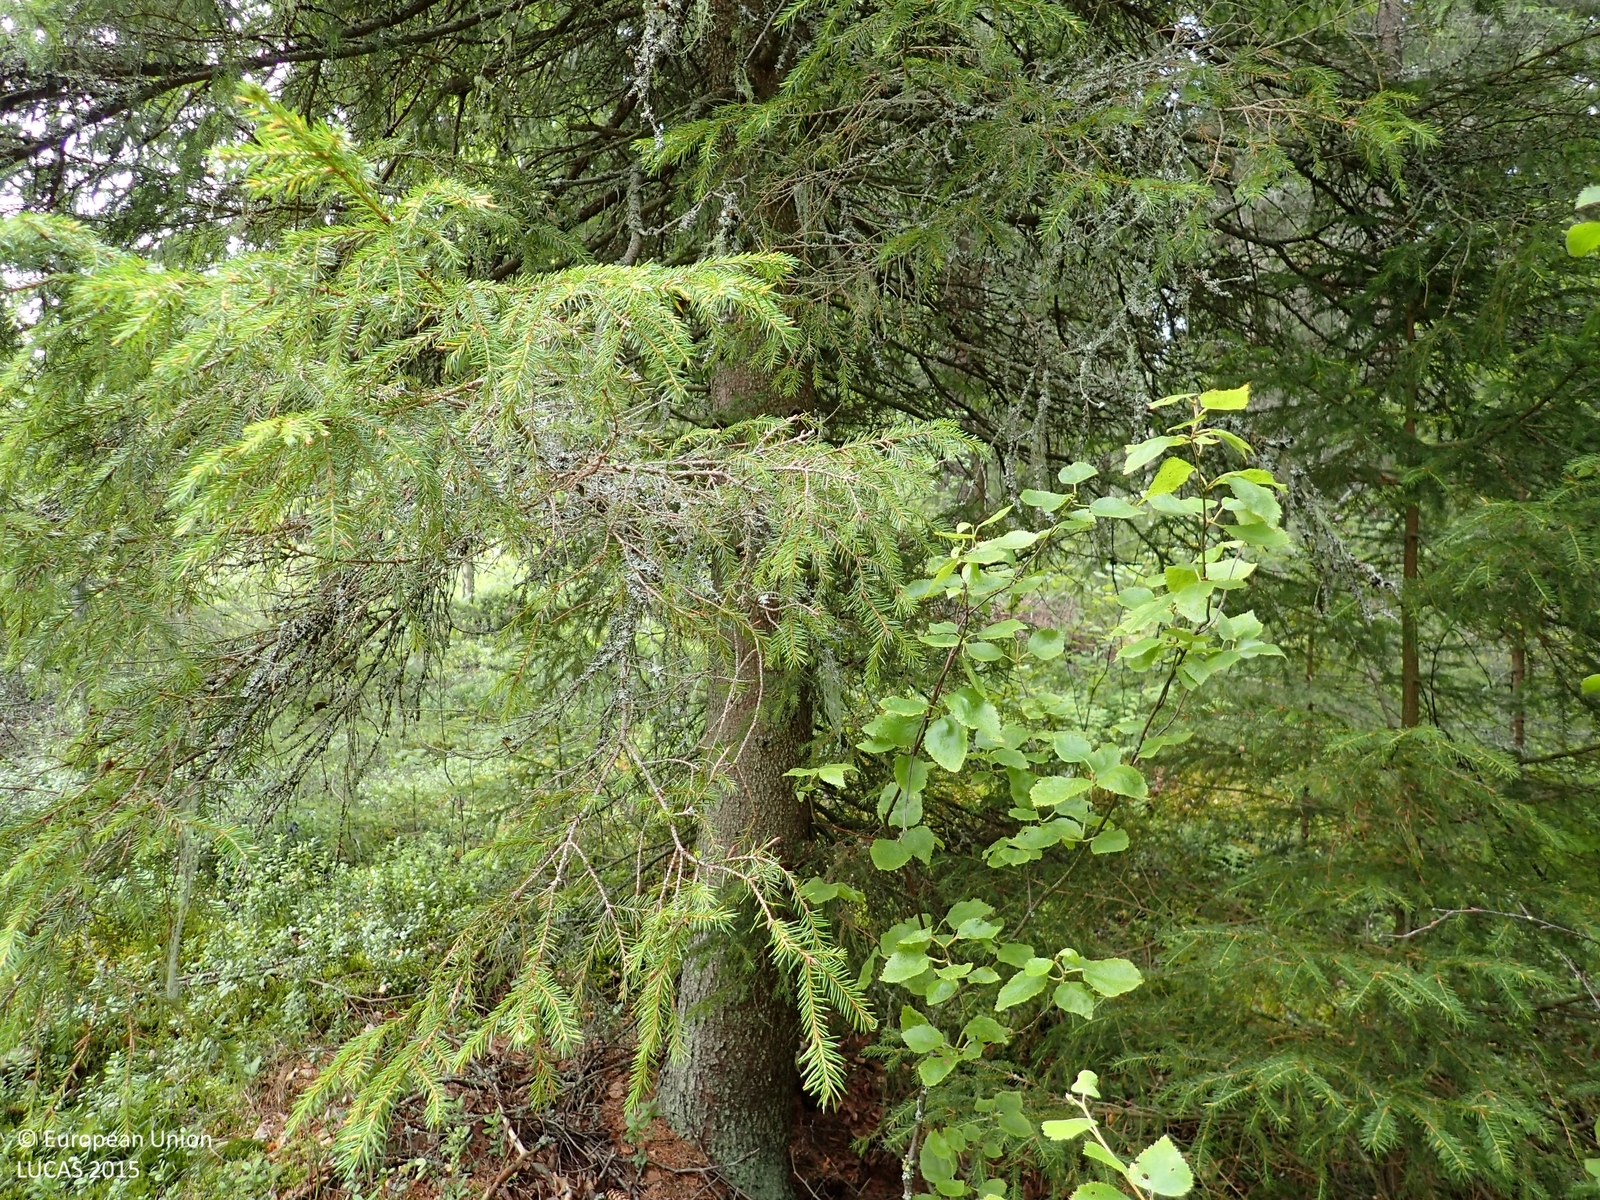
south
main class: Woodland
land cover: Spruce dominated mixed woodland
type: boreal forest
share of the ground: > 75 %
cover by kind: coniferous forest trees 55 %, broadleaved forest trees 20 %, shrubs 20 %, herbaceous plants 5 %
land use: Forestry
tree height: > 5 m
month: July
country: FI
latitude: 62.8889
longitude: 22.3436
